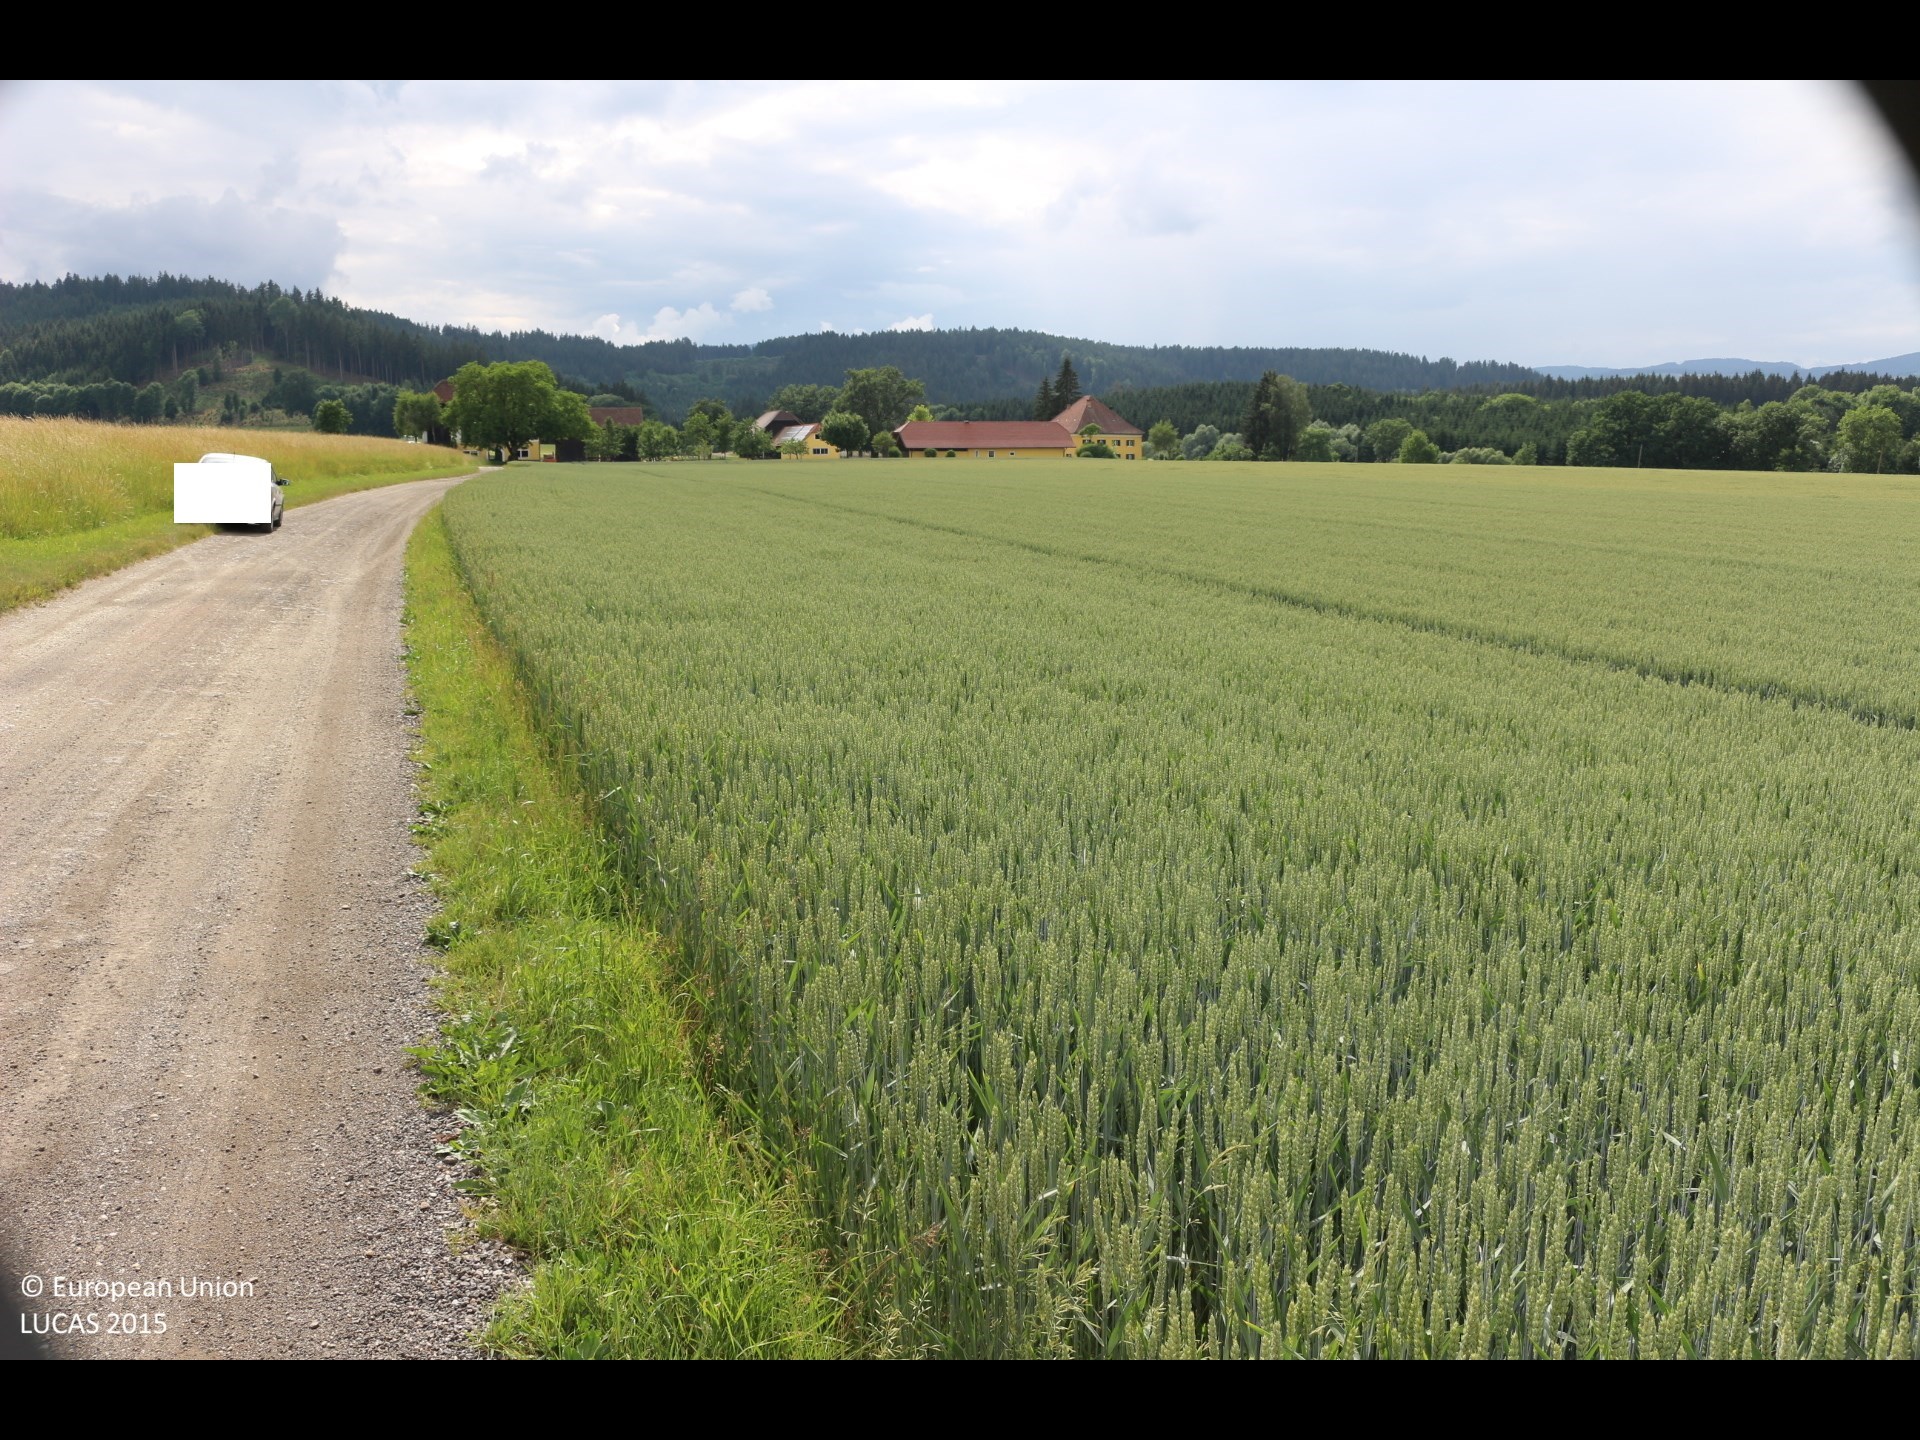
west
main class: Cropland
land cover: Common wheat
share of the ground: > 75 %
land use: Agriculture (excluding fallow land and kitchen gardens)
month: June
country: AT
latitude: 46.8361
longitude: 14.4426
